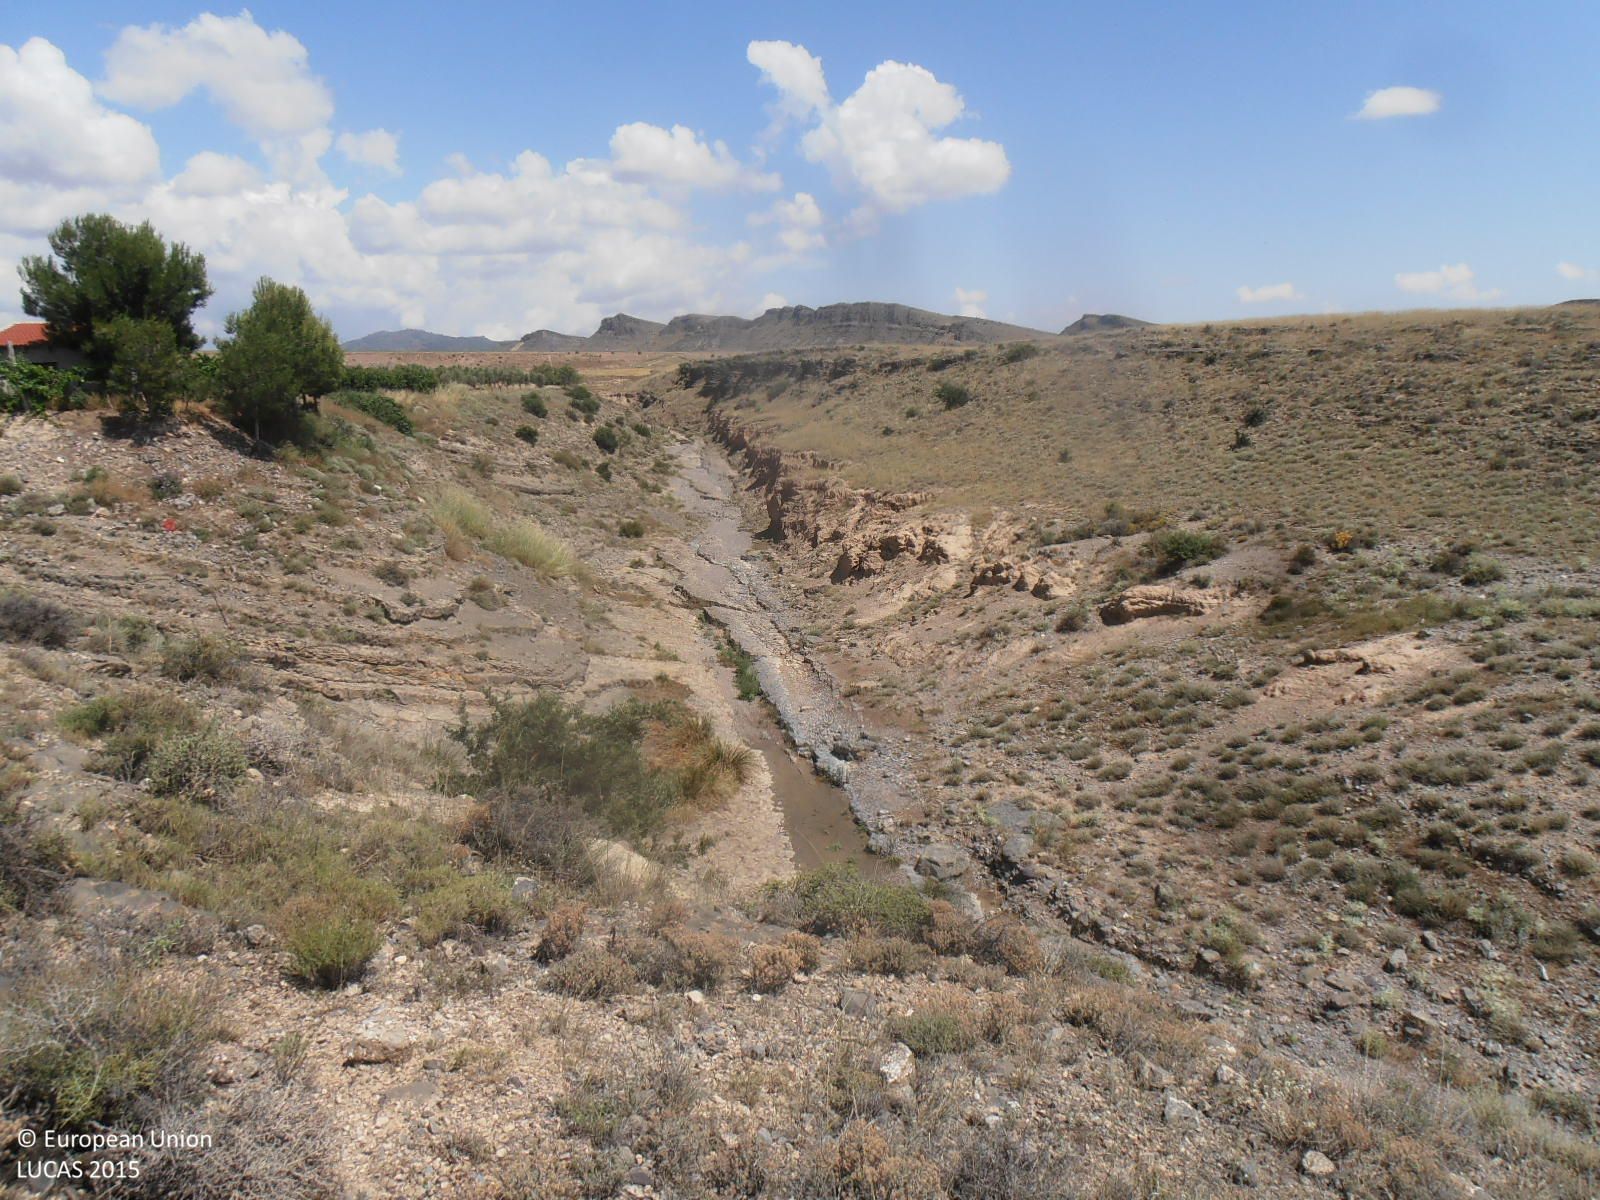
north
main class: Shrubland
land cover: Shrubland without tree cover
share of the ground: 25 - 50 %
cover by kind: consolidated bare surface 55 %, shrubs 40 %, herbaceous plants 5 %
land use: Semi-natural and natural areas not in use
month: June
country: ES
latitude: 41.5138
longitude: -1.4198
